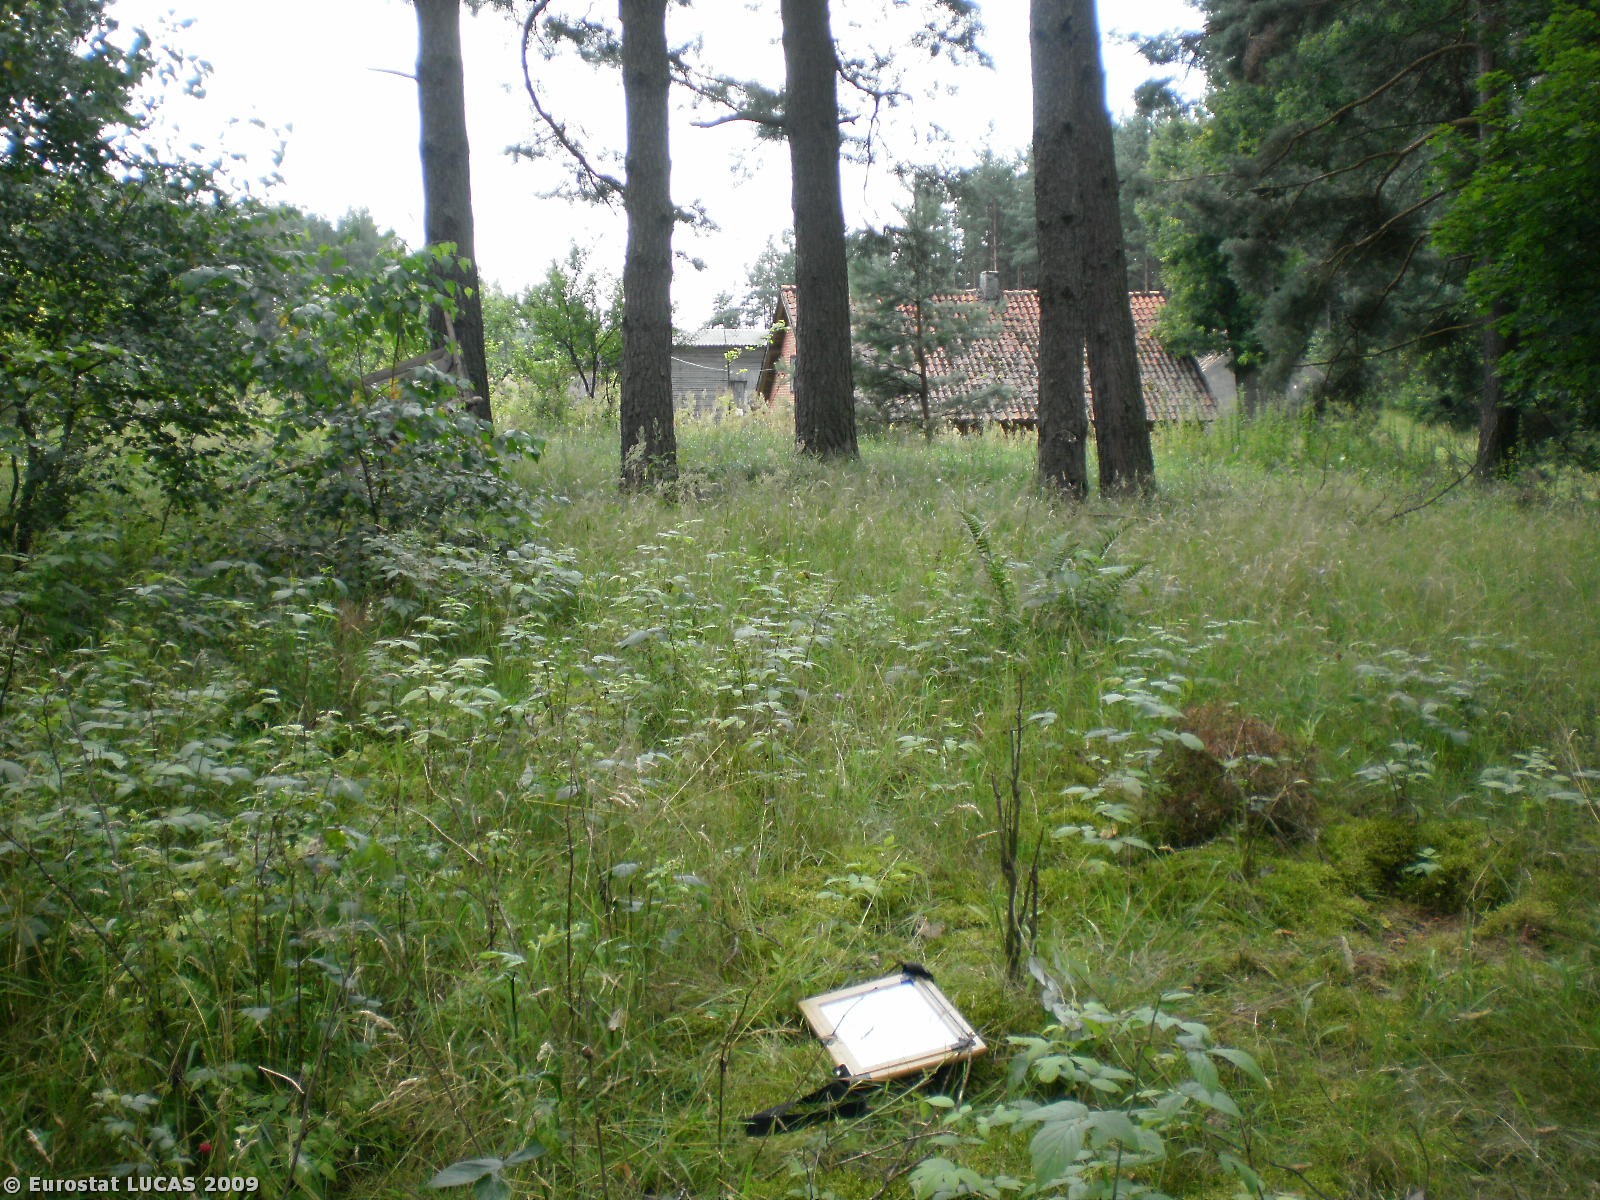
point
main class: Woodland
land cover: Coniferous woodland
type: hemiboreal forest and nemoral coniferous forest and mixed broadleaved-coniferous forest
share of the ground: > 75 %
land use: Forestry
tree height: > 5 m
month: July
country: PL
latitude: 53.4898
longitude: 20.4818
